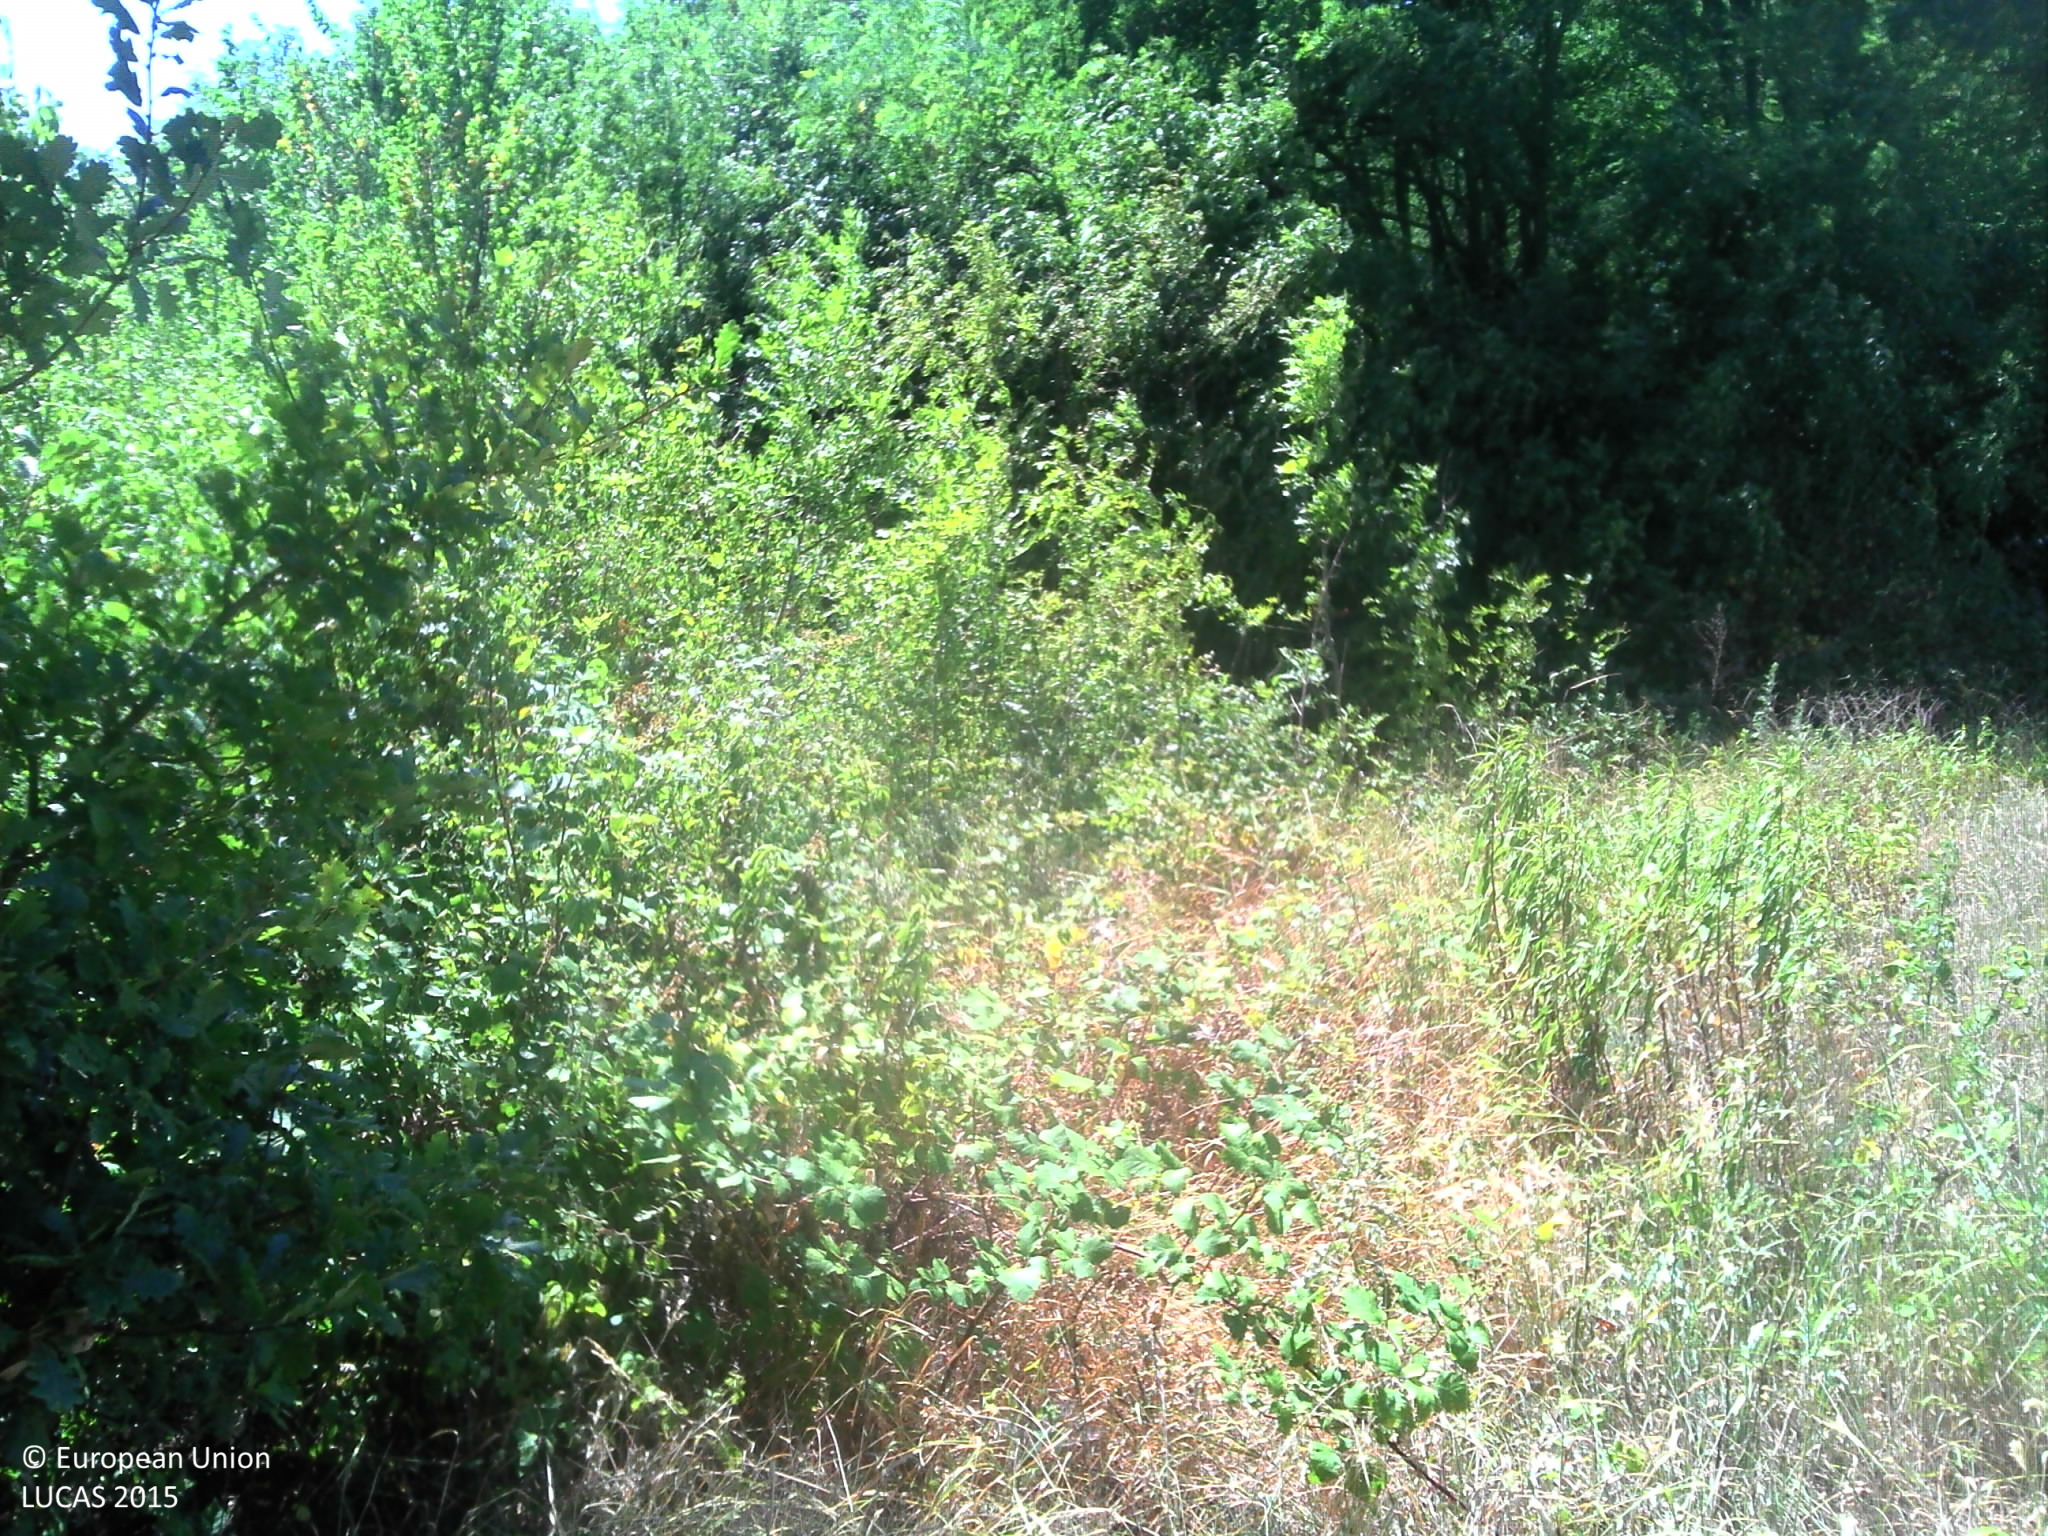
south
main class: Woodland
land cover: Broadleaved woodland
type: mesophytic deciduous forest
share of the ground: > 75 %
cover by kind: broadleaved forest trees 90 %, herbaceous plants 10 %
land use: Forestry
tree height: > 5 m
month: July
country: FR
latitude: 45.5601
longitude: 4.8668
